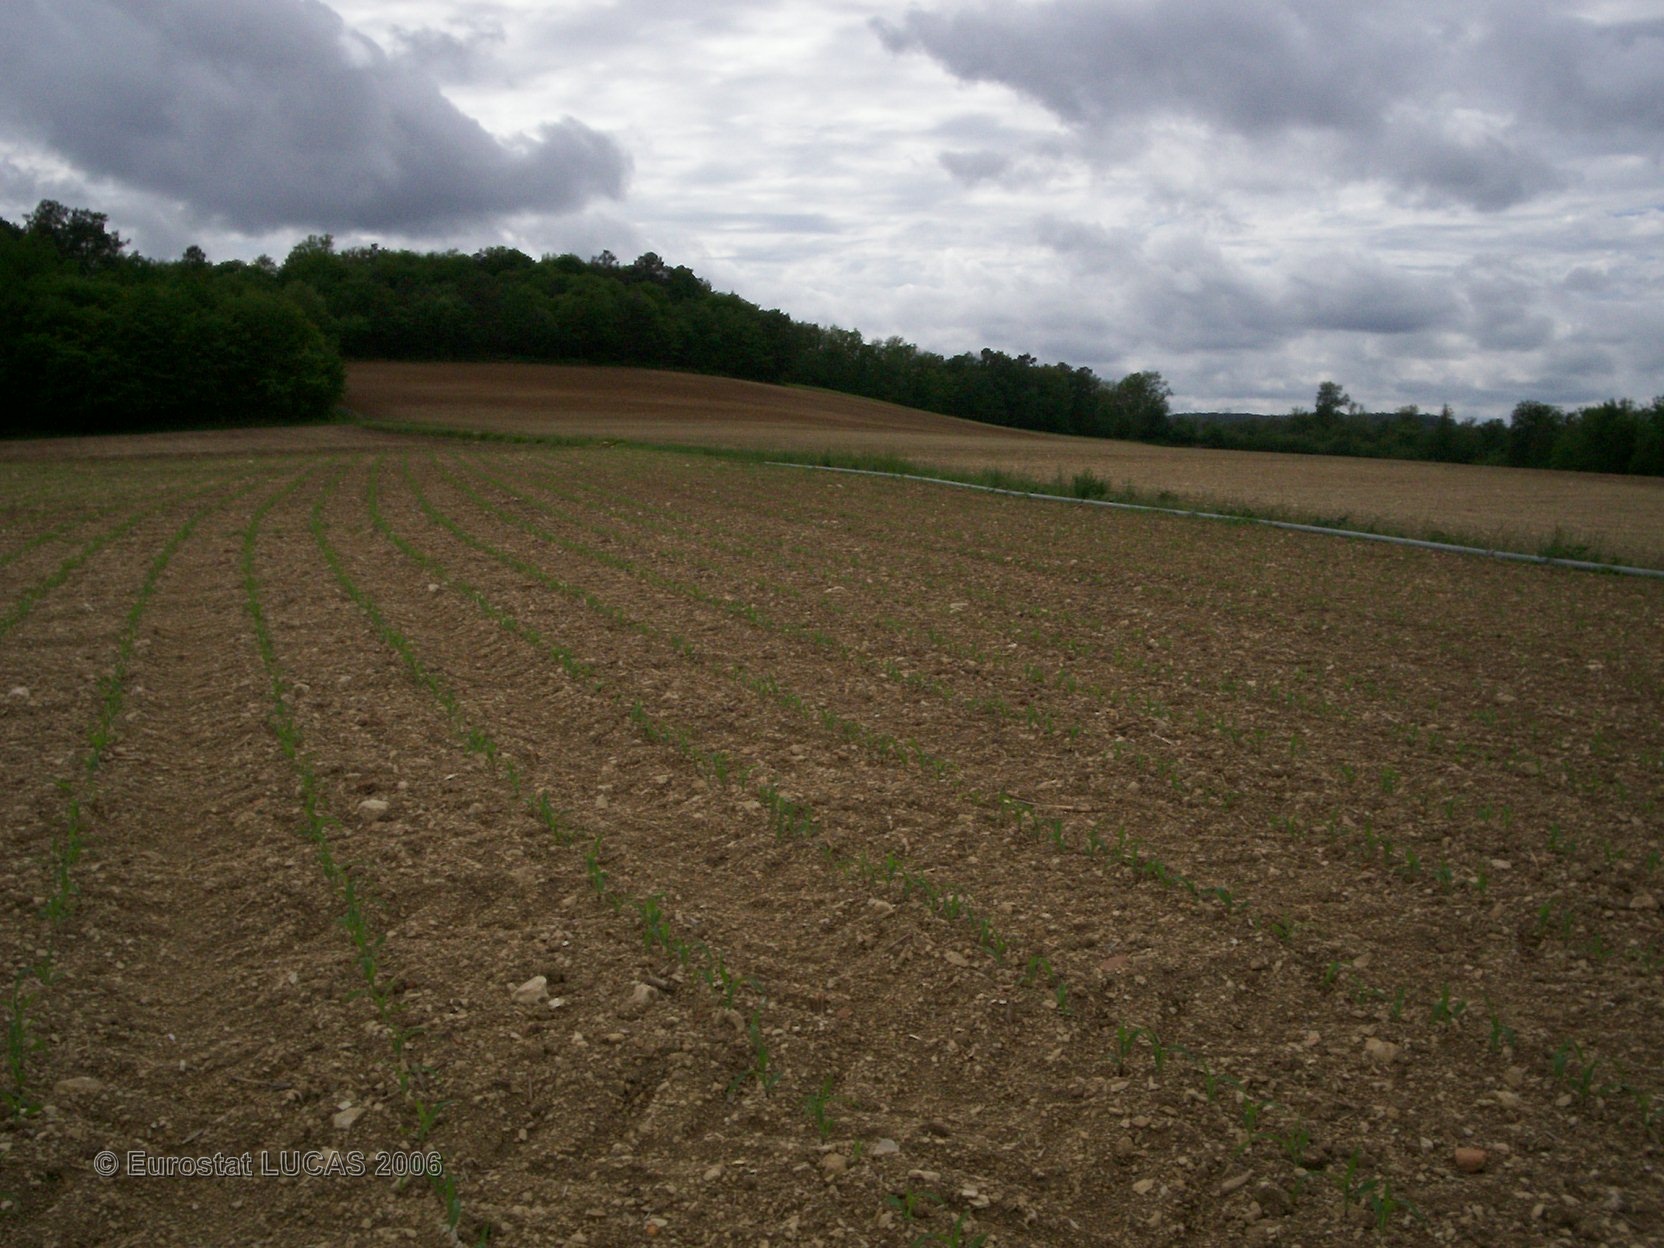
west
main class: Cropland
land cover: Maize
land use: Agriculture (excluding fallow land and kitchen gardens)
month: May
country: FR
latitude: 45.2986
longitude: 0.5645
